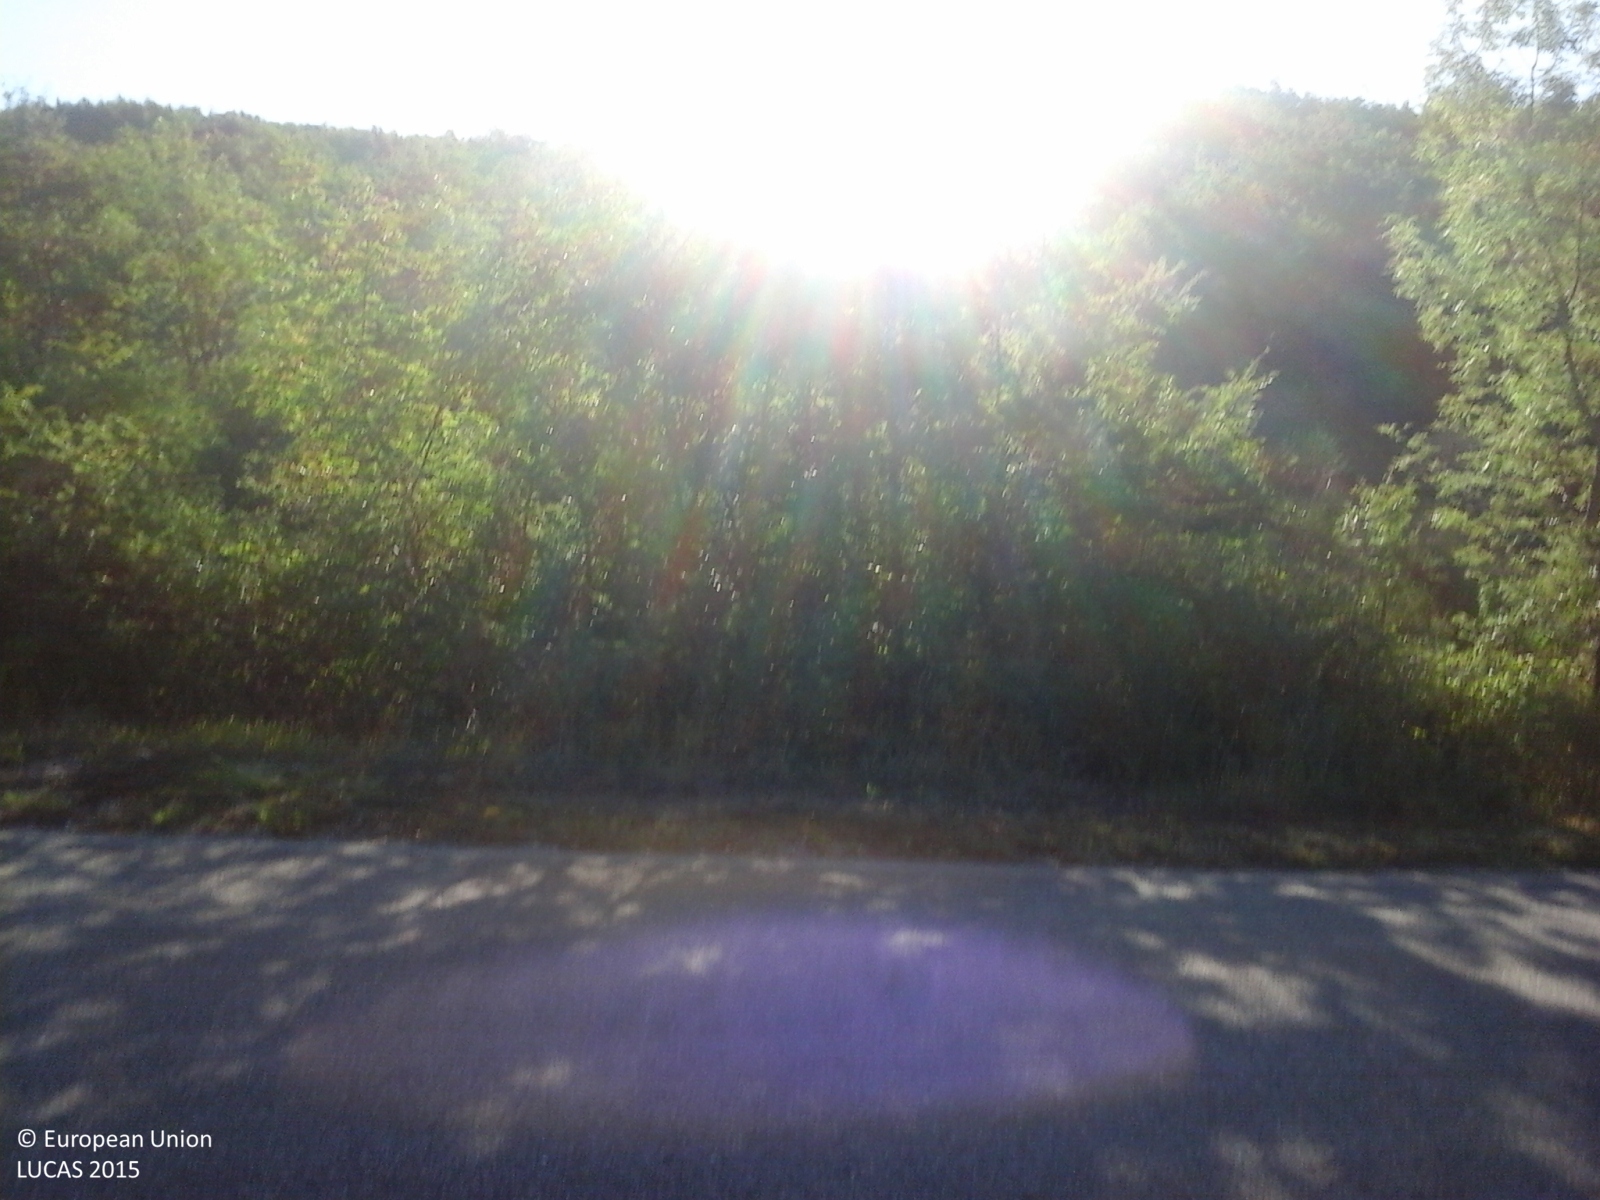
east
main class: Woodland
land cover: Broadleaved woodland
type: thermophilous deciduous forest
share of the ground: > 75 %
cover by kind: broadleaved forest trees 75 %, shrubs 20 %, herbaceous plants 5 %
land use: Forestry
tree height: > 5 m
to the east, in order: Broadleaved woodland; Temporary grasslands; Broadleaved woodland; Grass margins; Paved roads, cycling and walking lanes
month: August
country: IT
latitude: 42.7679
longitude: 11.5958
